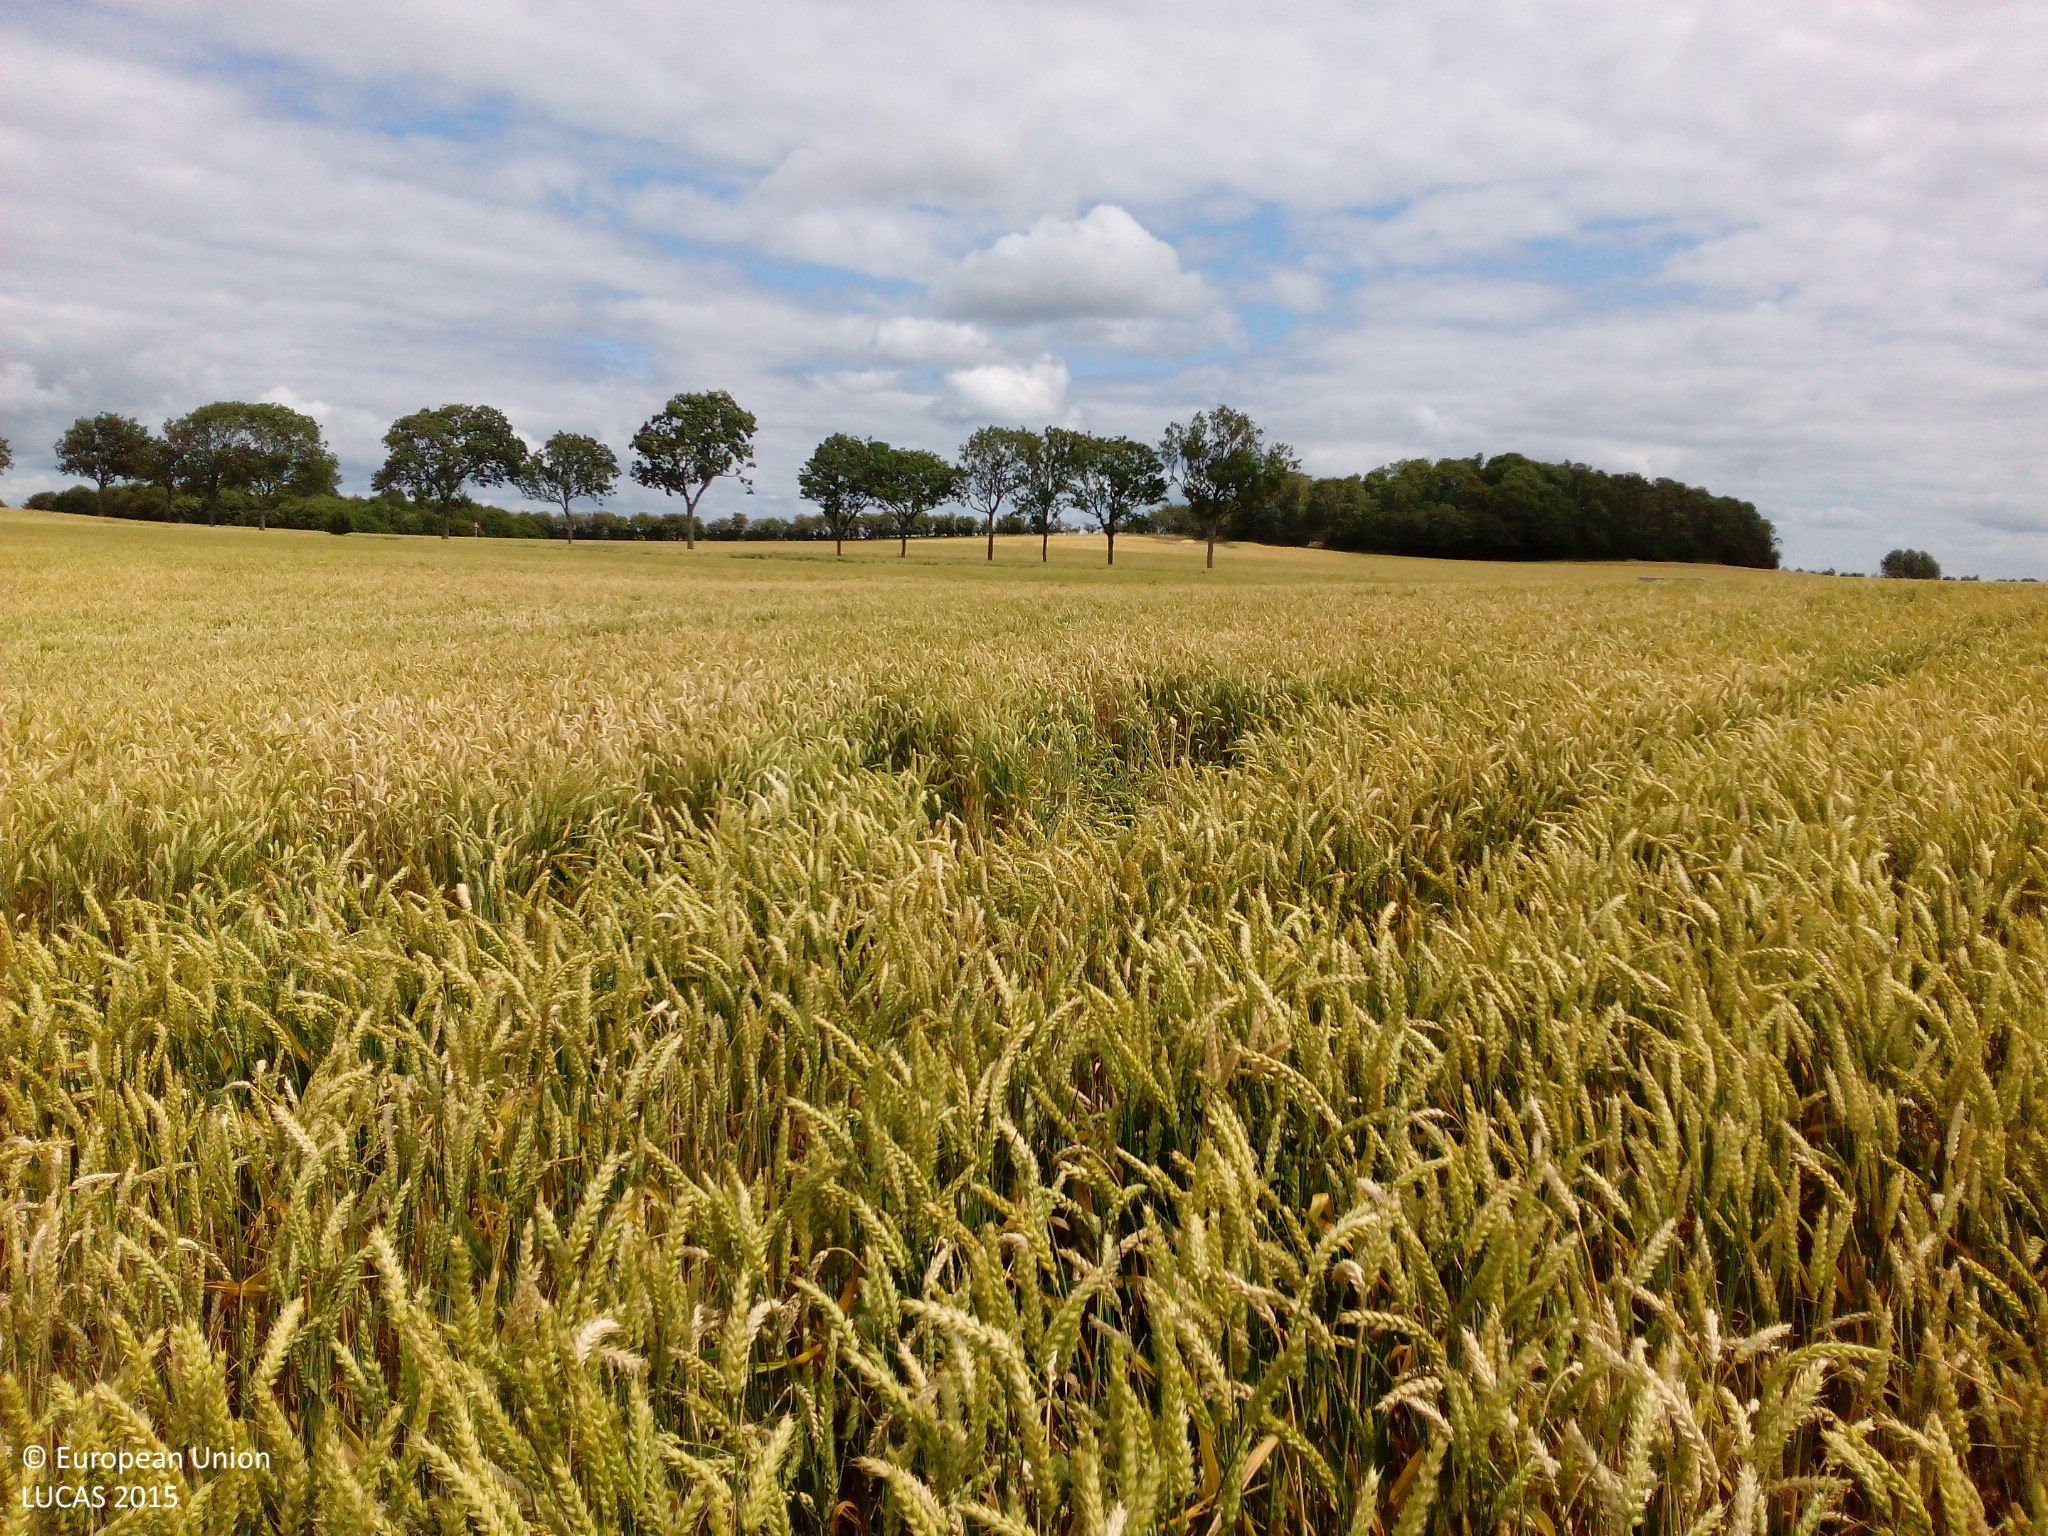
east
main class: Cropland
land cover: Common wheat
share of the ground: > 75 %
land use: Agriculture (excluding fallow land and kitchen gardens)
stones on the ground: < 10 %
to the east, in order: Common wheat; Lines of trees; Paved roads, cycling and walking lanes; Grass margins; Common wheat
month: July
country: DK
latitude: 55.9897
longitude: 12.1620
